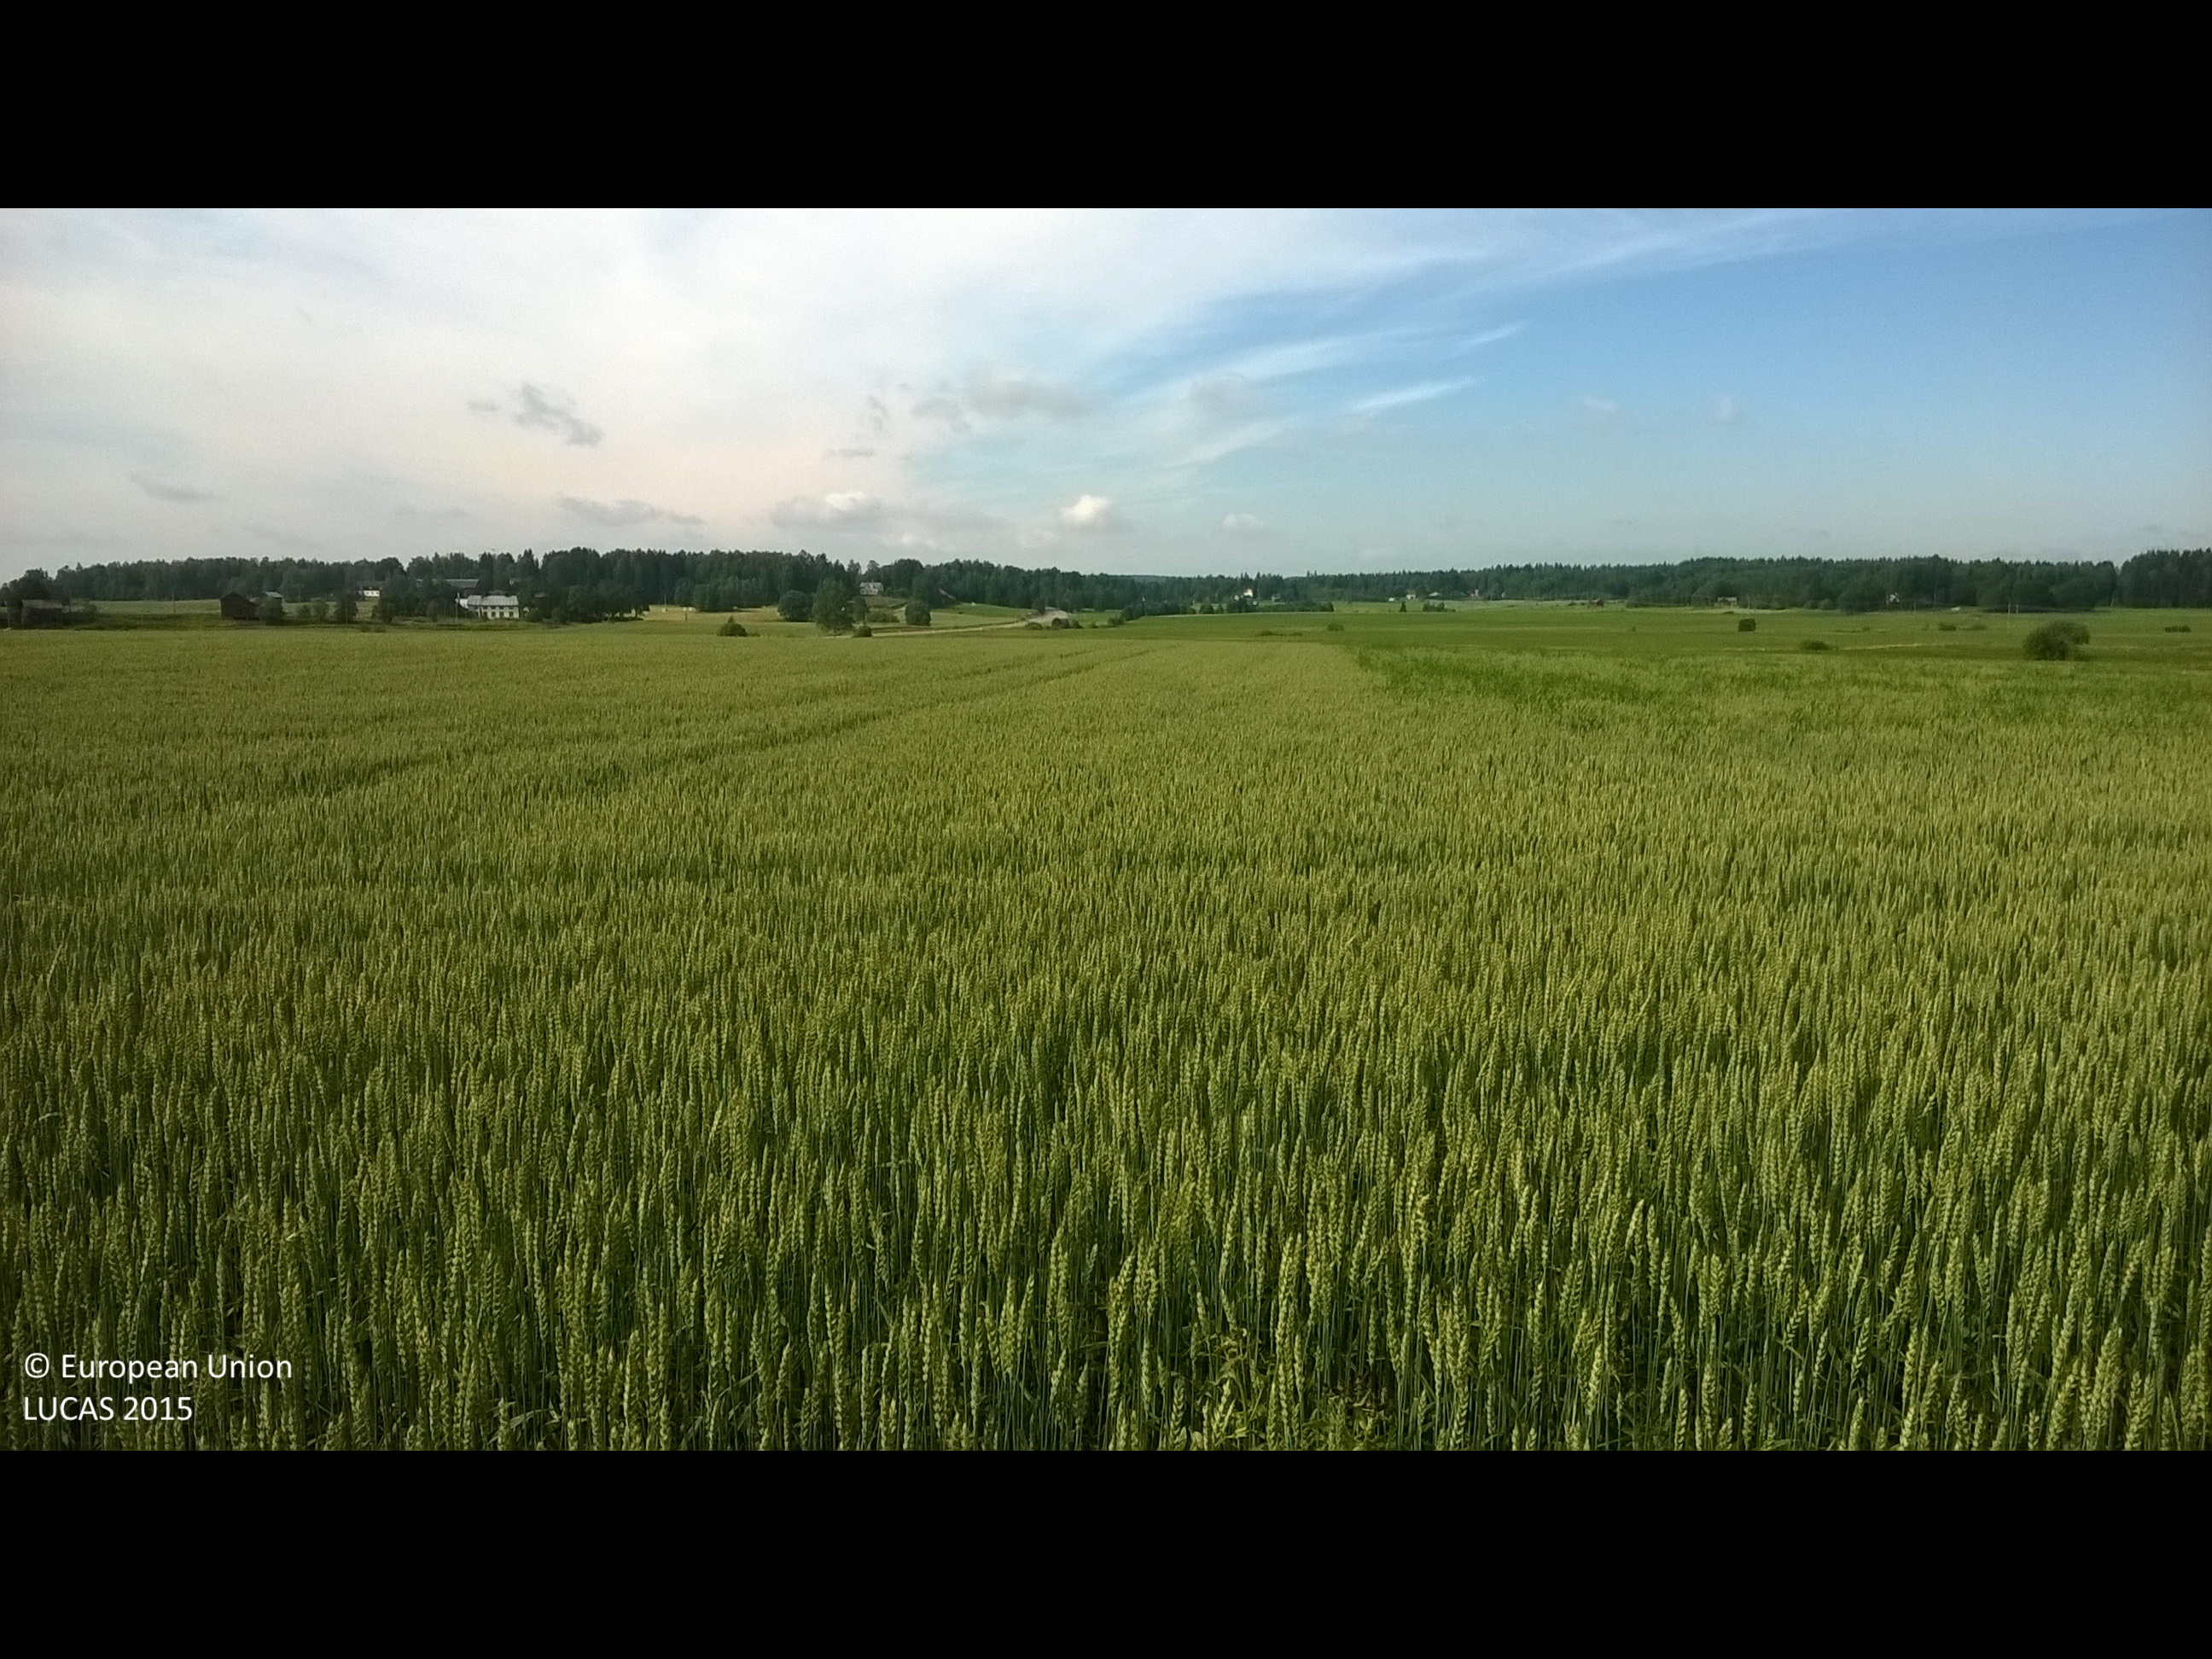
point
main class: Cropland
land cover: Common wheat
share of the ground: > 75 %
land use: Agriculture (excluding fallow land and kitchen gardens)
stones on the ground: < 10 %
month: August
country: SE
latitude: 60.6054
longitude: 16.5818
